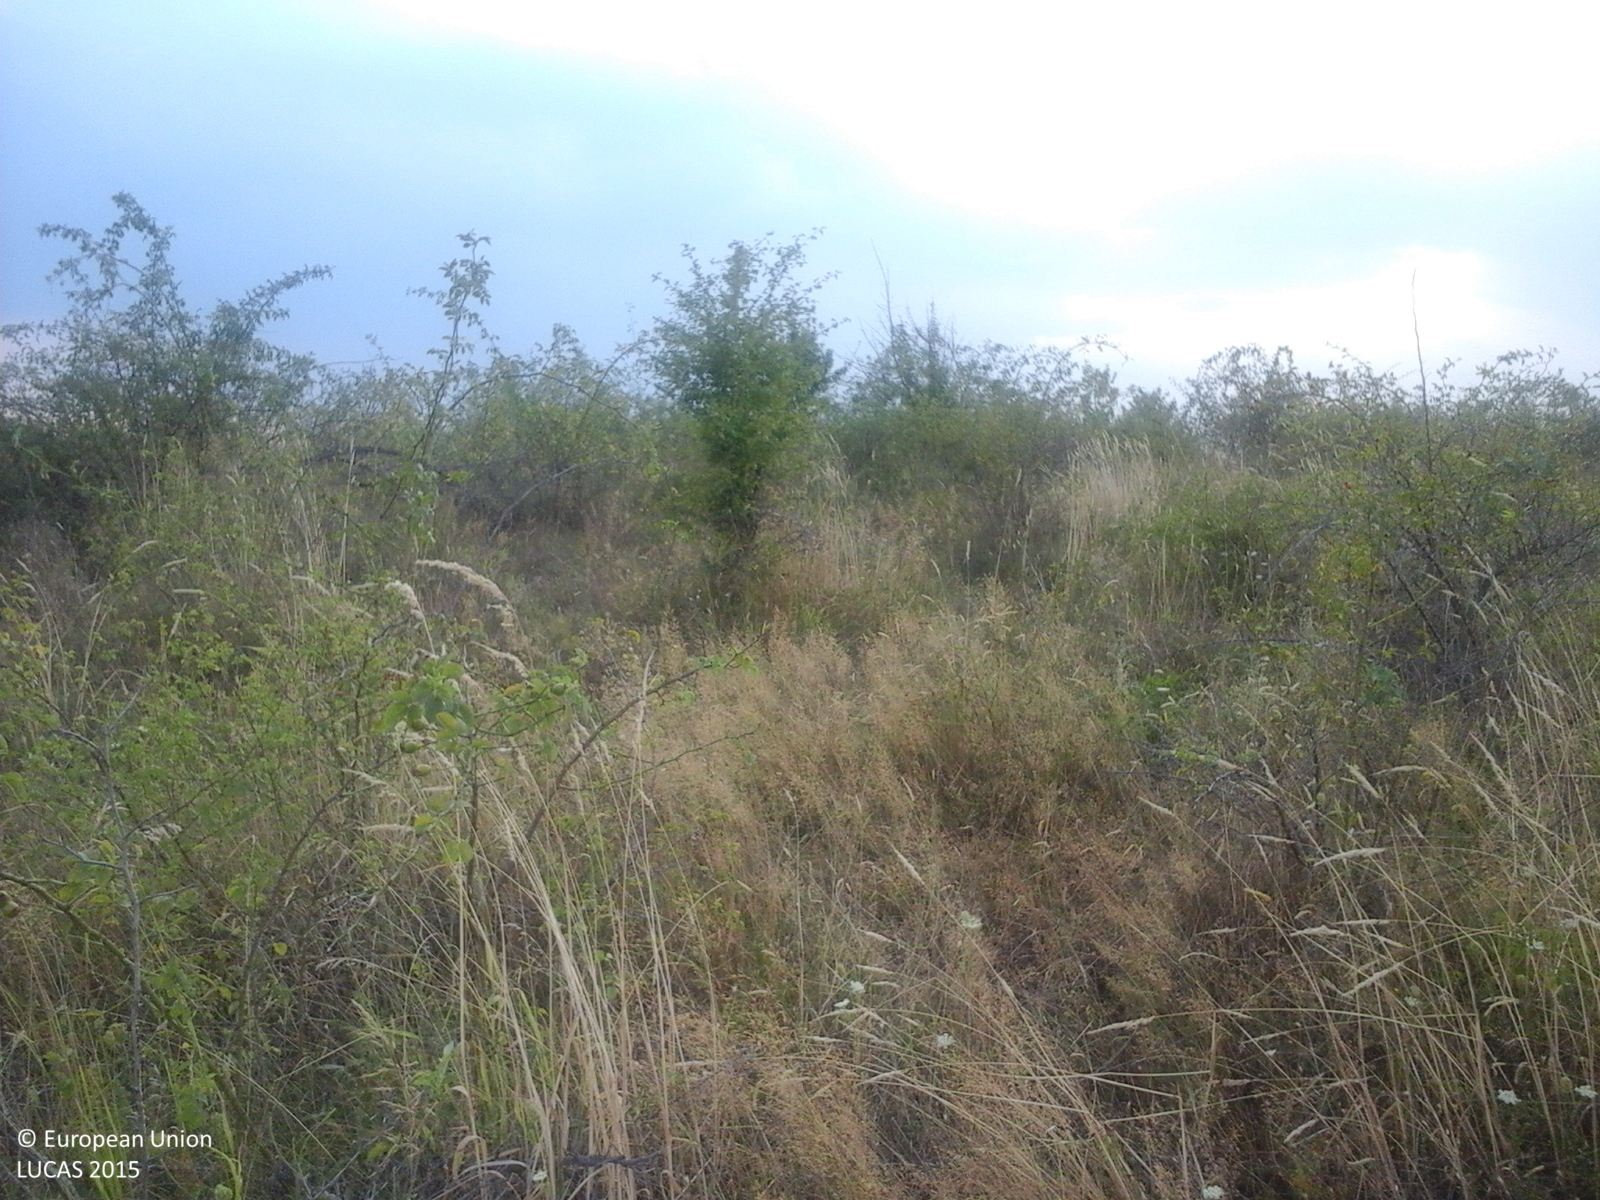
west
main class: Shrubland
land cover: Shrubland with sparse tree cover
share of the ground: > 75 %
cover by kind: herbaceous plants 85 %, shrubs 10 %, broadleaved forest trees 5 %
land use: Semi-natural and natural areas not in use
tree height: < 5 m
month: August
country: RO
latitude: 44.7671
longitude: 23.5888
